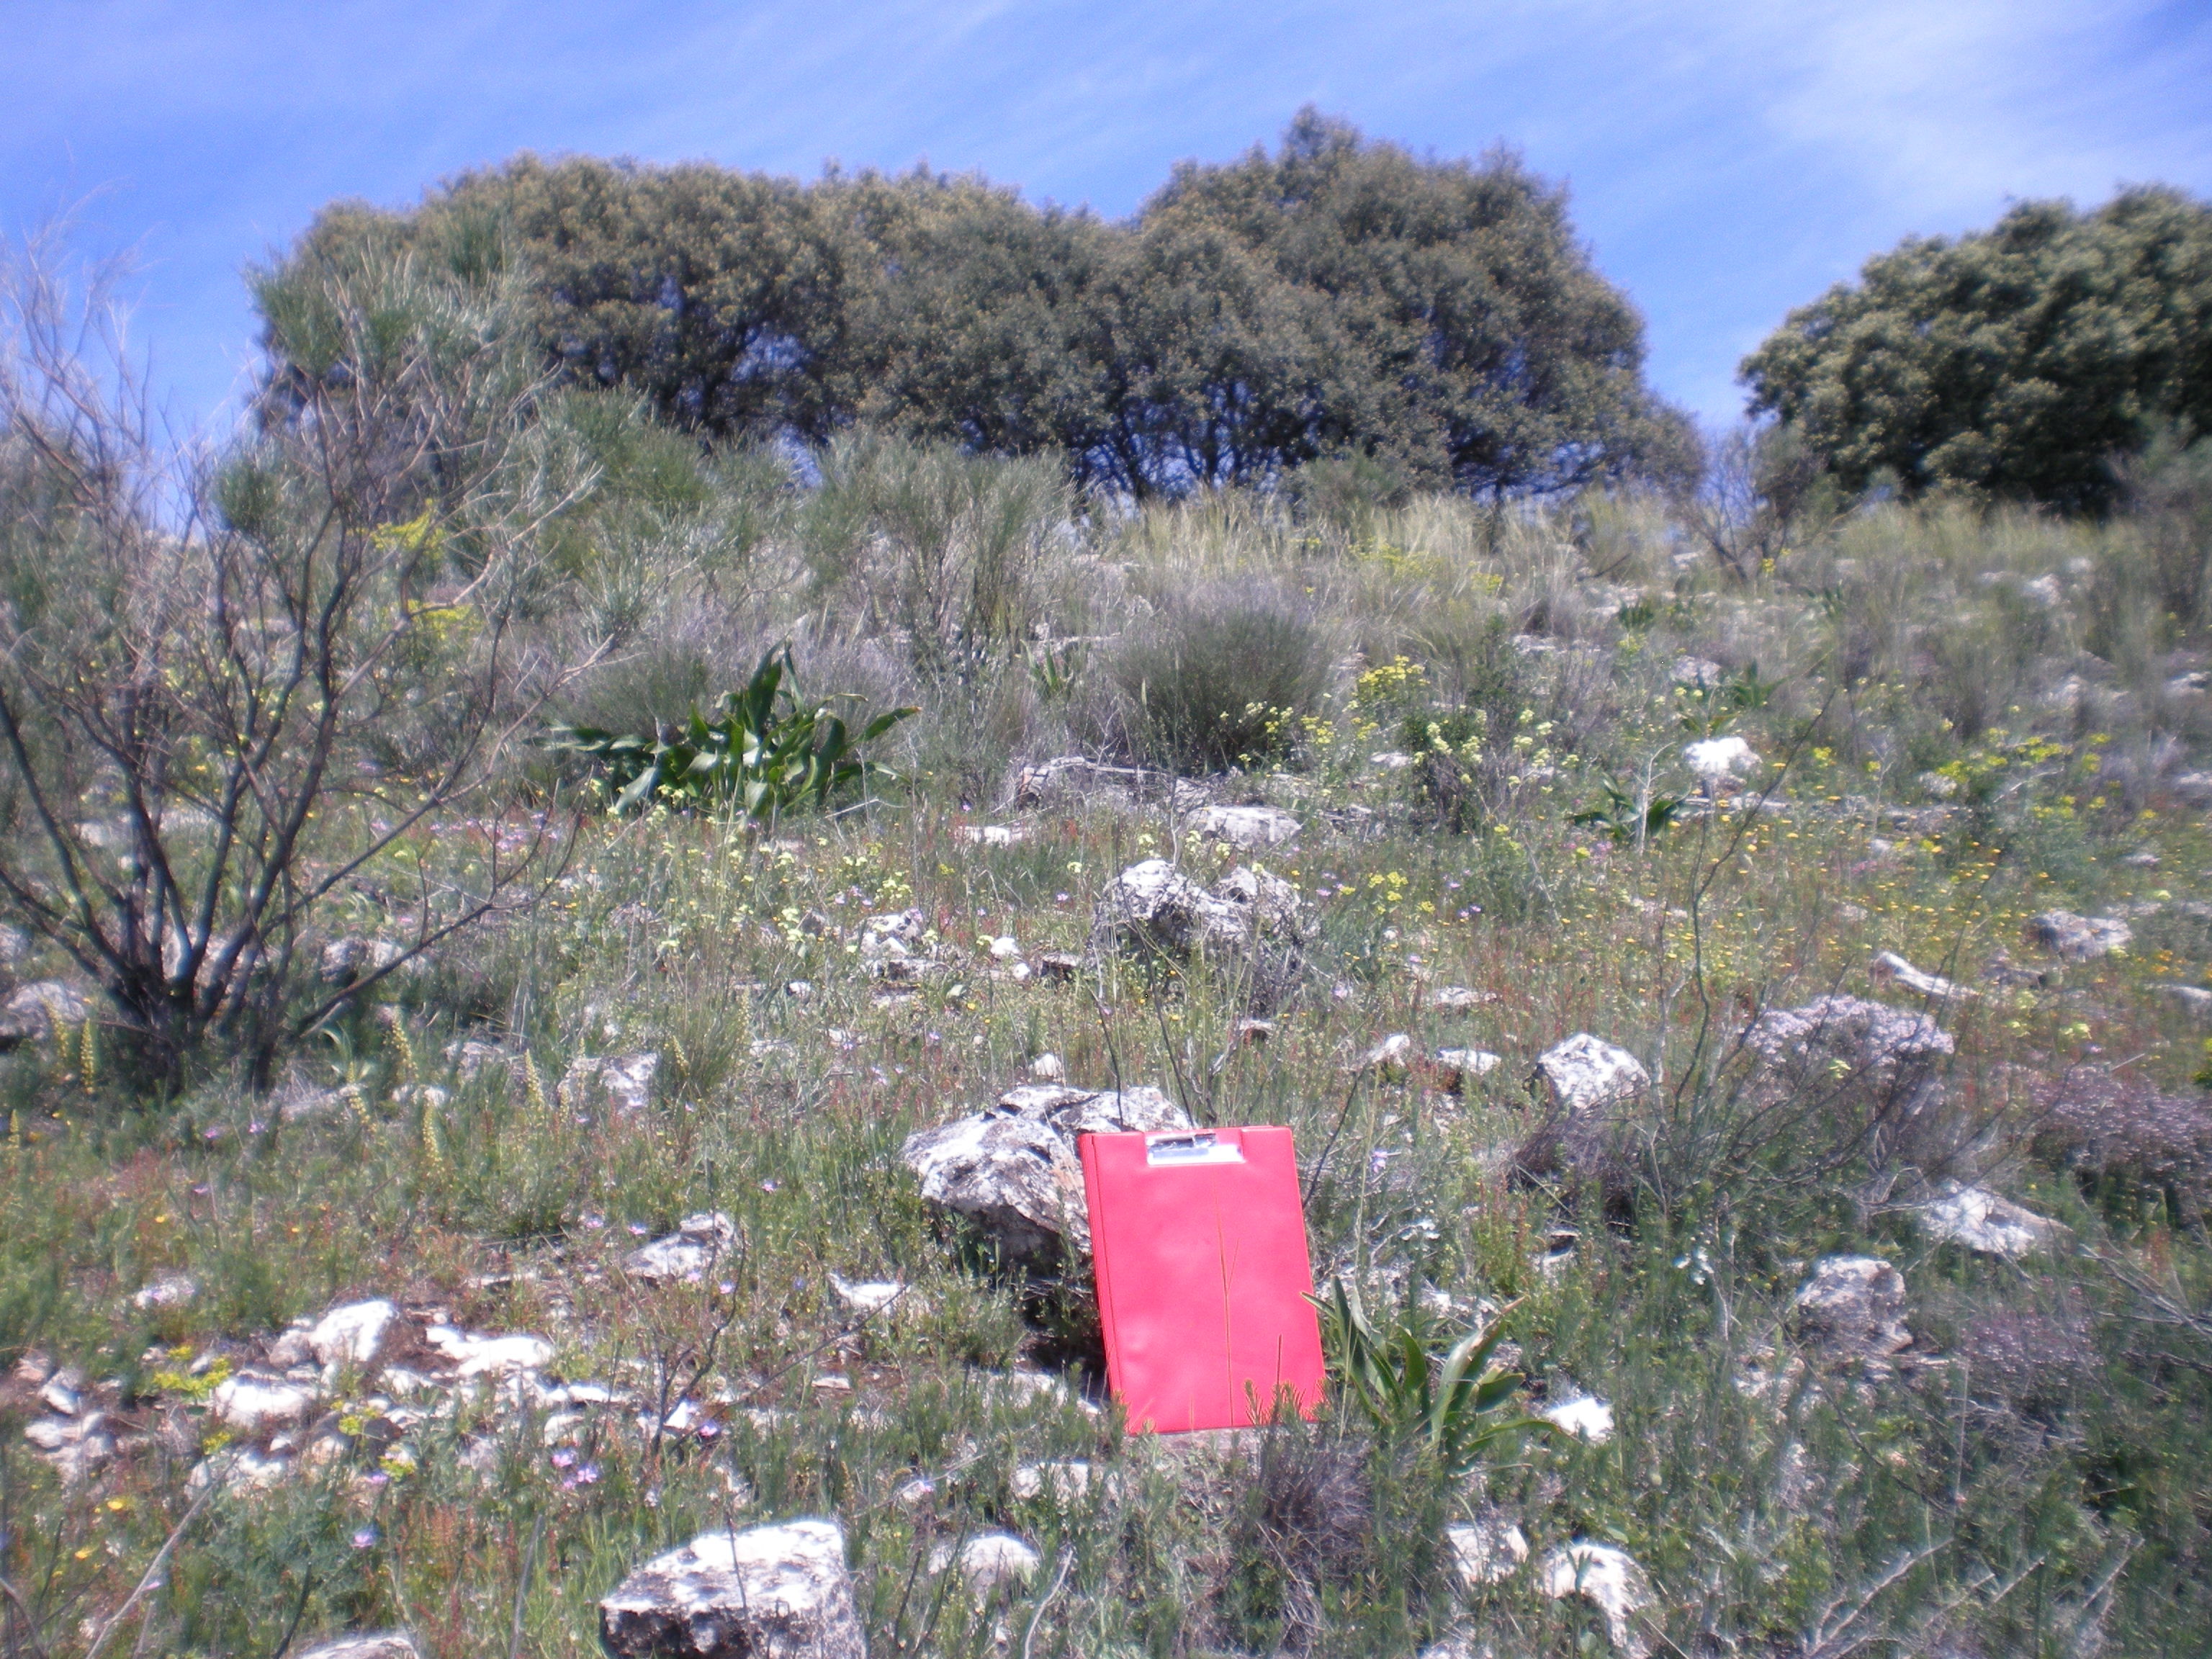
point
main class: Shrubland
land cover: Shrubland with sparse tree cover
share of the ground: 10 - 25 %
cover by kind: herbaceous plants 50 %, consolidated bare surface 30 %, shrubs 15 %, broadleaved forest trees 5 %
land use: Semi-natural and natural areas not in use
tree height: < 5 m
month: April
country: ES
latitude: 38.5915
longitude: -2.8737
